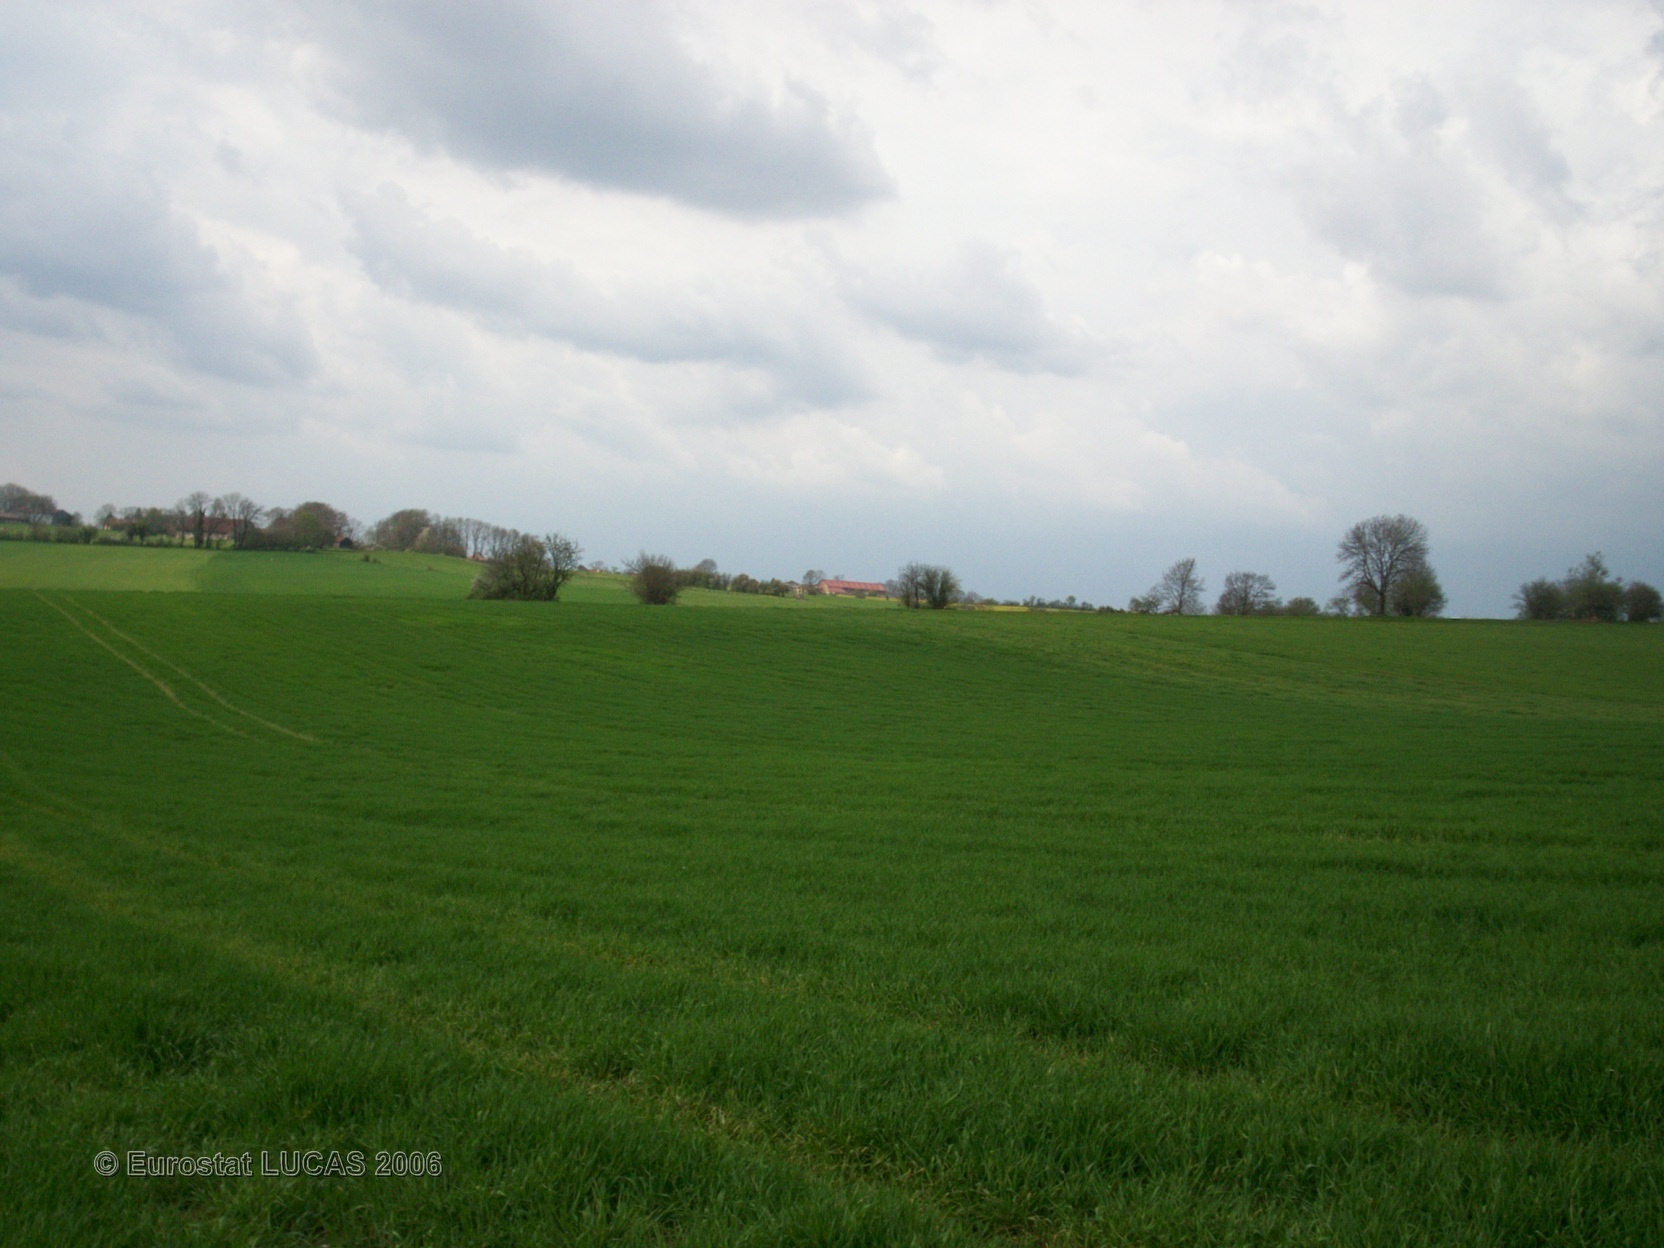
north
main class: Cropland
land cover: Barley
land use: Agriculture (excluding fallow land and kitchen gardens)
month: May
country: FR
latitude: 47.1191
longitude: 6.3775
